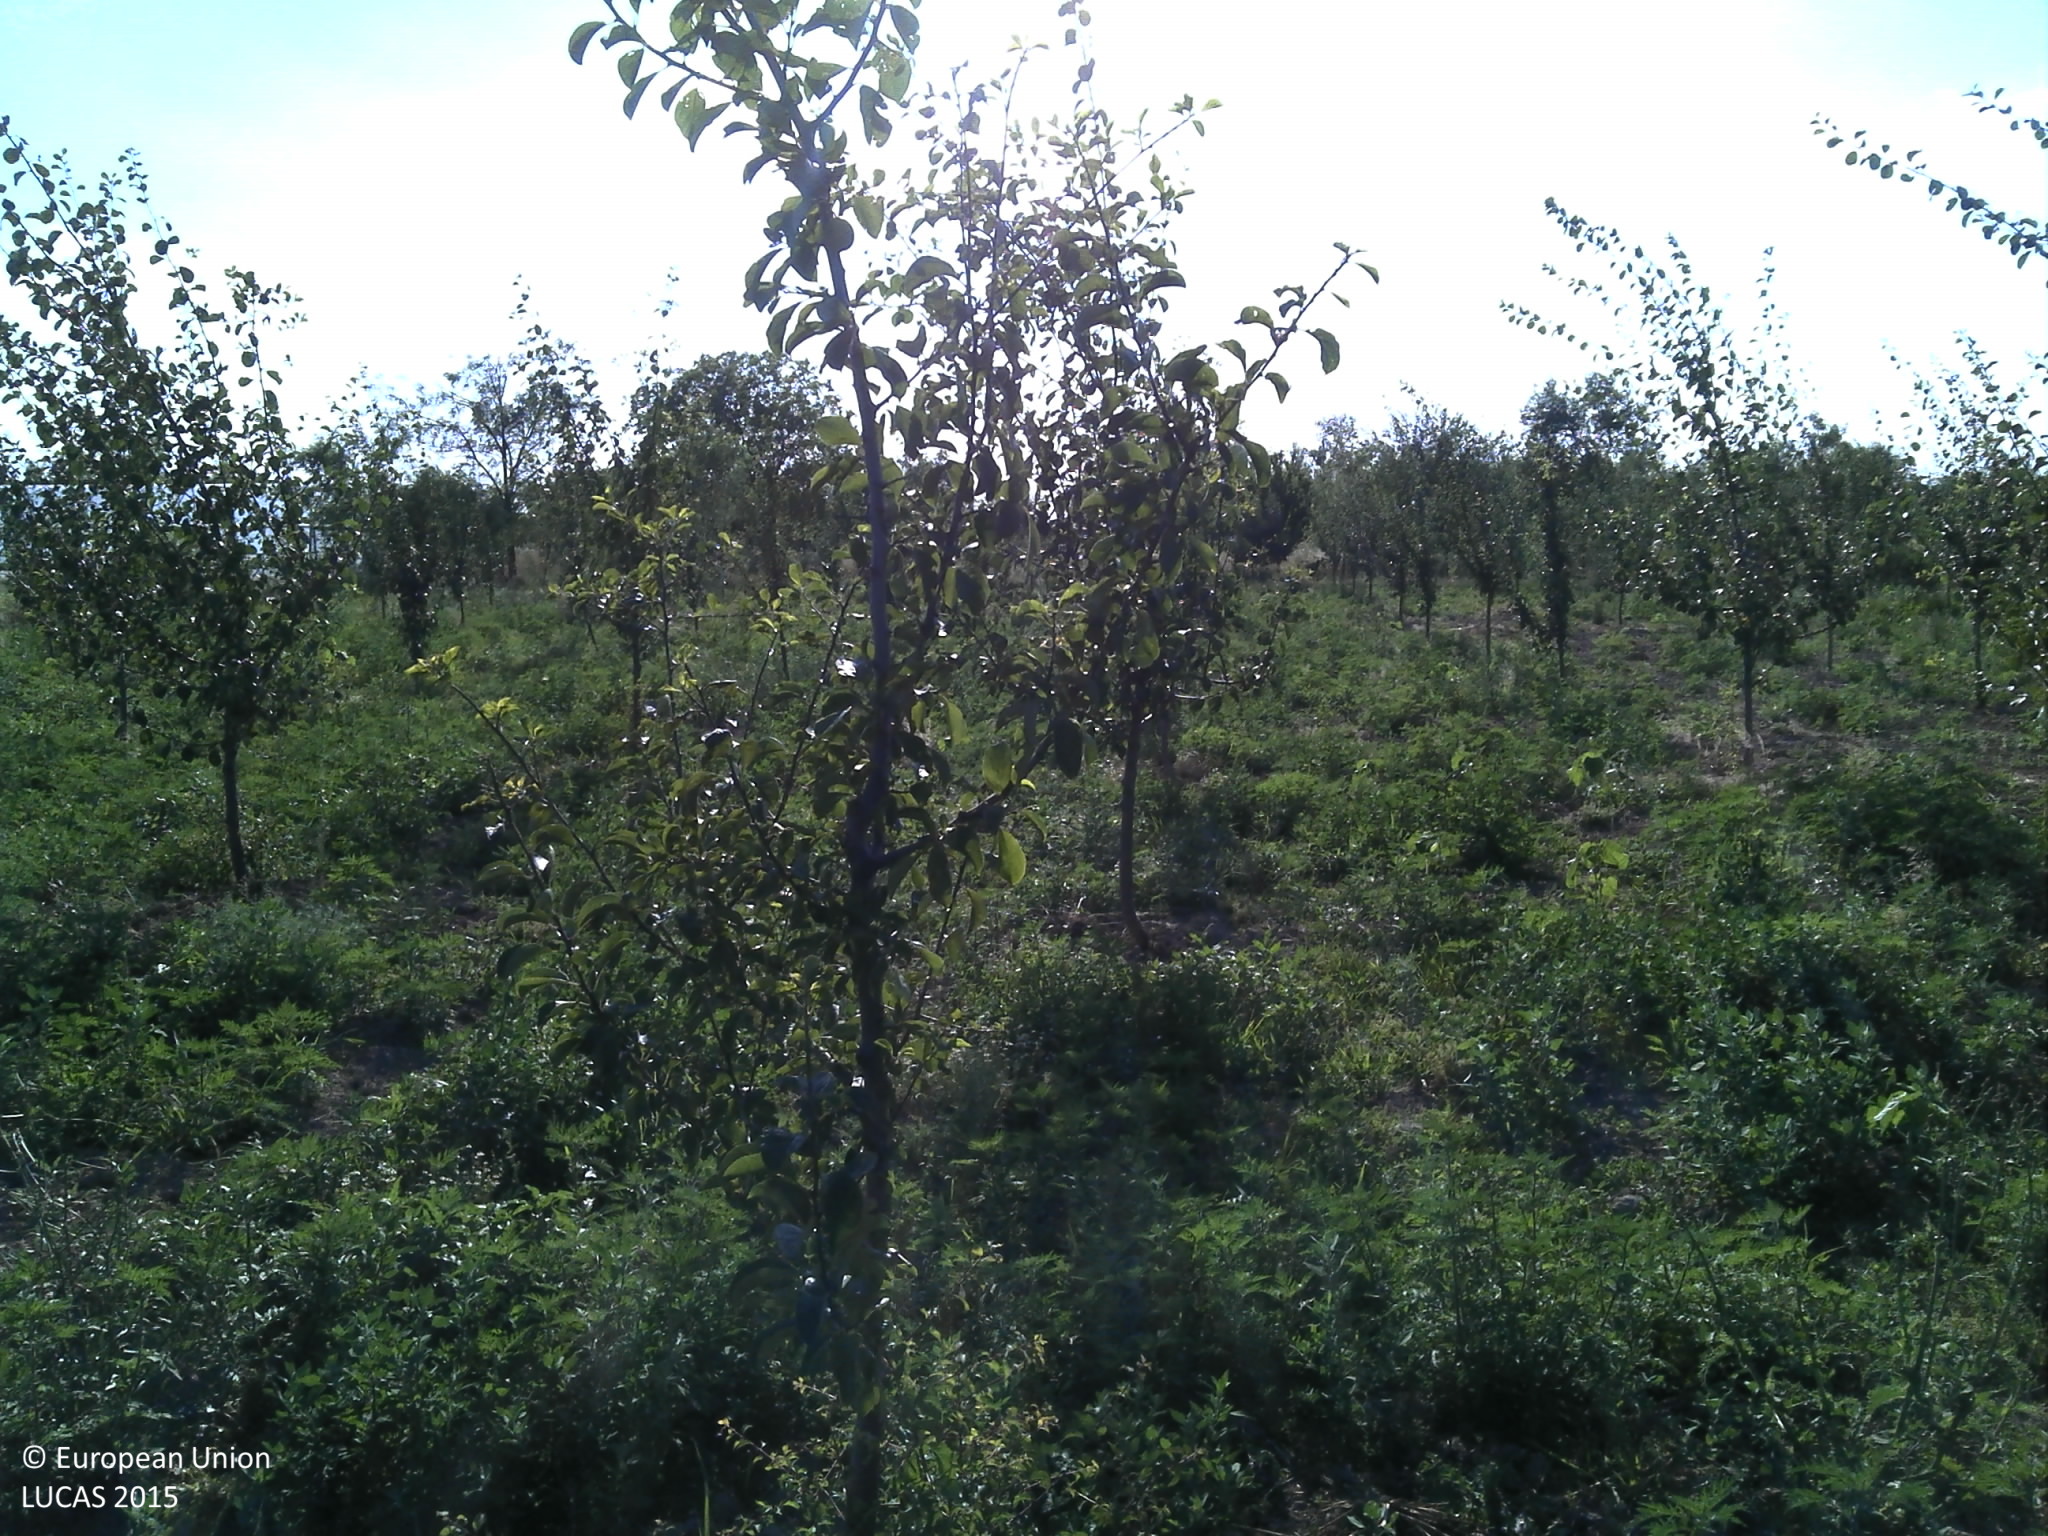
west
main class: Cropland
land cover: Other fruit trees and berries
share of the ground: 10 - 25 %
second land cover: Spontaneously vegetated surfaces
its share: 25 - 50 %
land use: Agriculture (excluding fallow land and kitchen gardens)
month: July
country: HR
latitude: 45.2953
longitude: 18.4082
